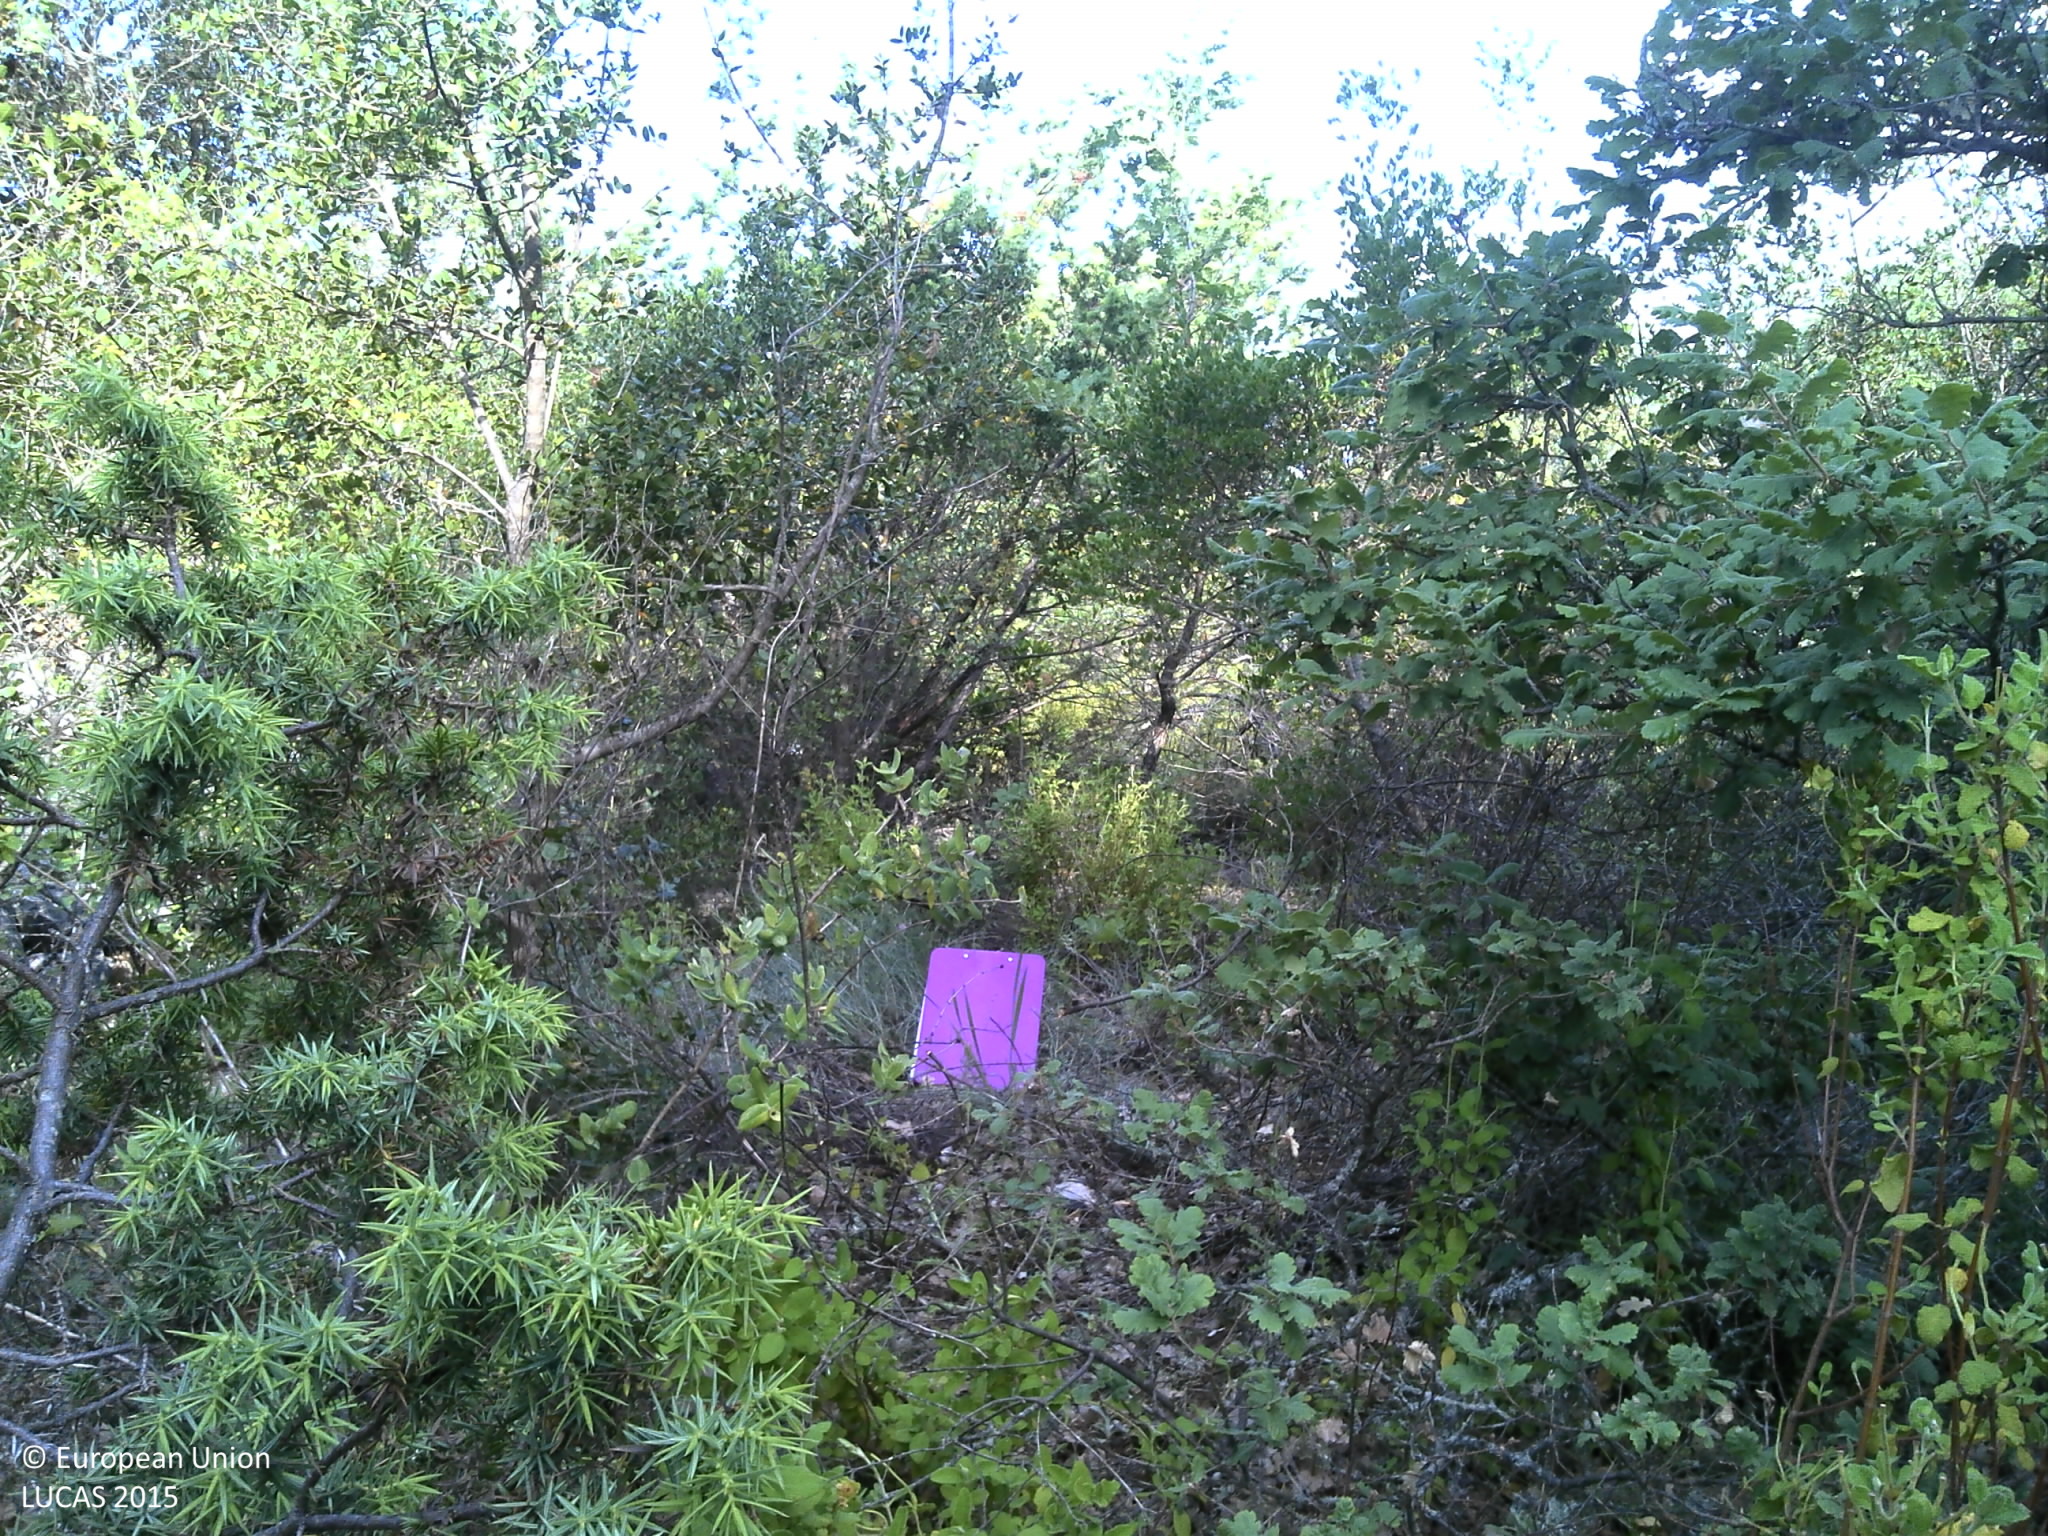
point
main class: Woodland
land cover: Other mixed woodland
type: coniferous forest of the mediterranean region
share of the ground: 25 - 50 %
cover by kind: herbaceous plants 30 %, broadleaved forest trees 20 %, shrubs 20 %, unconsolidated bare surface 20 %, coniferous forest trees 10 %
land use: Semi-natural and natural areas not in use
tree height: > 5 m
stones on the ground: < 10 %
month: June
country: HR
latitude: 43.5234
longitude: 16.0404
